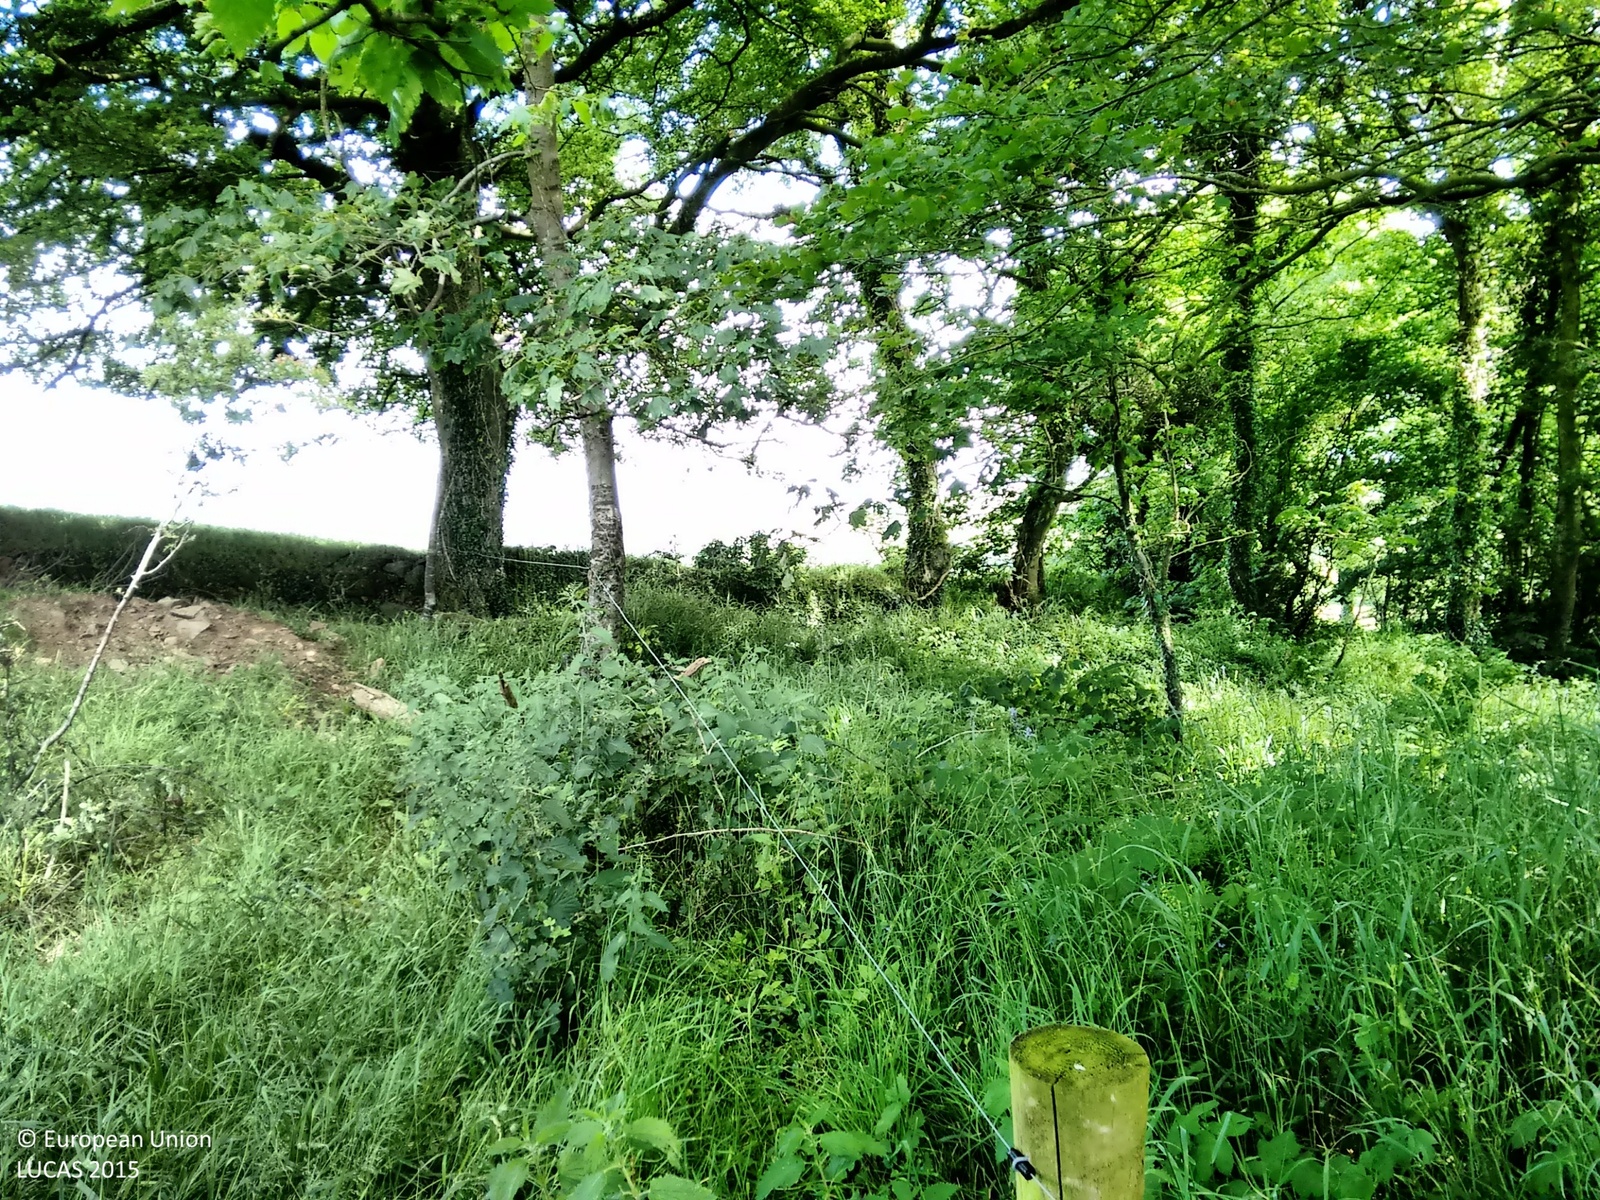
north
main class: Woodland
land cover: Broadleaved woodland
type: acidophilous oak and oak-birch forest
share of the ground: > 75 %
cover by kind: broadleaved forest trees 95 %, shrubs 5 %
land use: Semi-natural and natural areas not in use
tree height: > 5 m
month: June
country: IE
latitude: 52.1655
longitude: -7.3924
